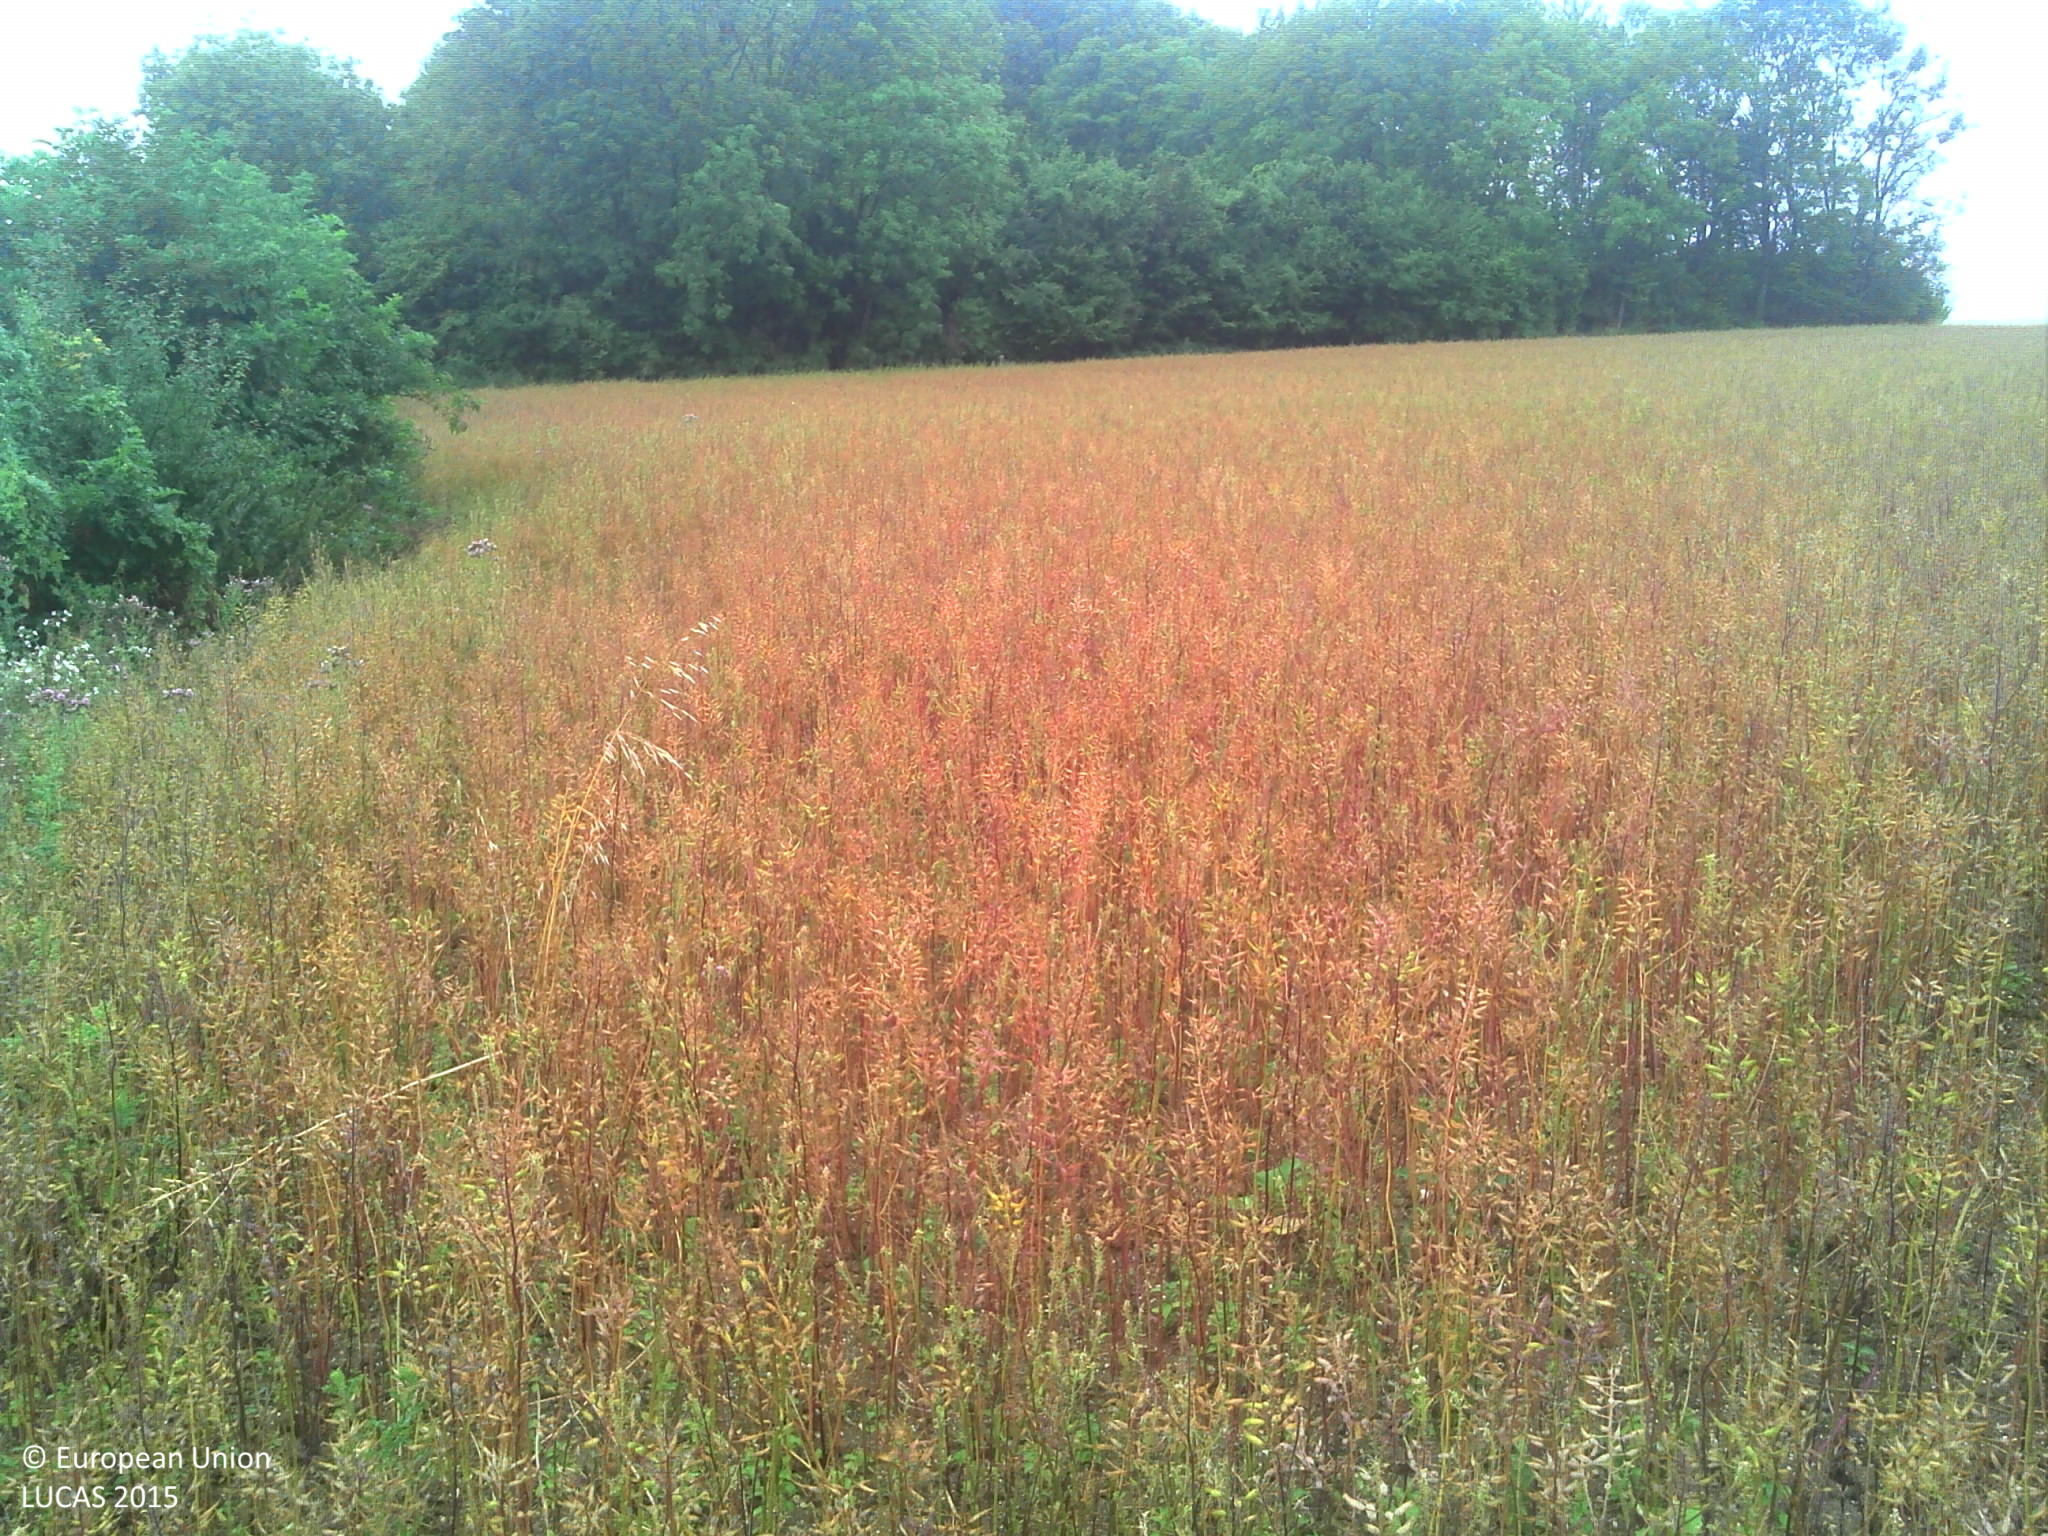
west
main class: Cropland
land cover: Other fibre and oleaginous crops
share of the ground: 50 - 75 %
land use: Agriculture (excluding fallow land and kitchen gardens)
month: July
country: FR
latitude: 49.6651
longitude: 3.6617
